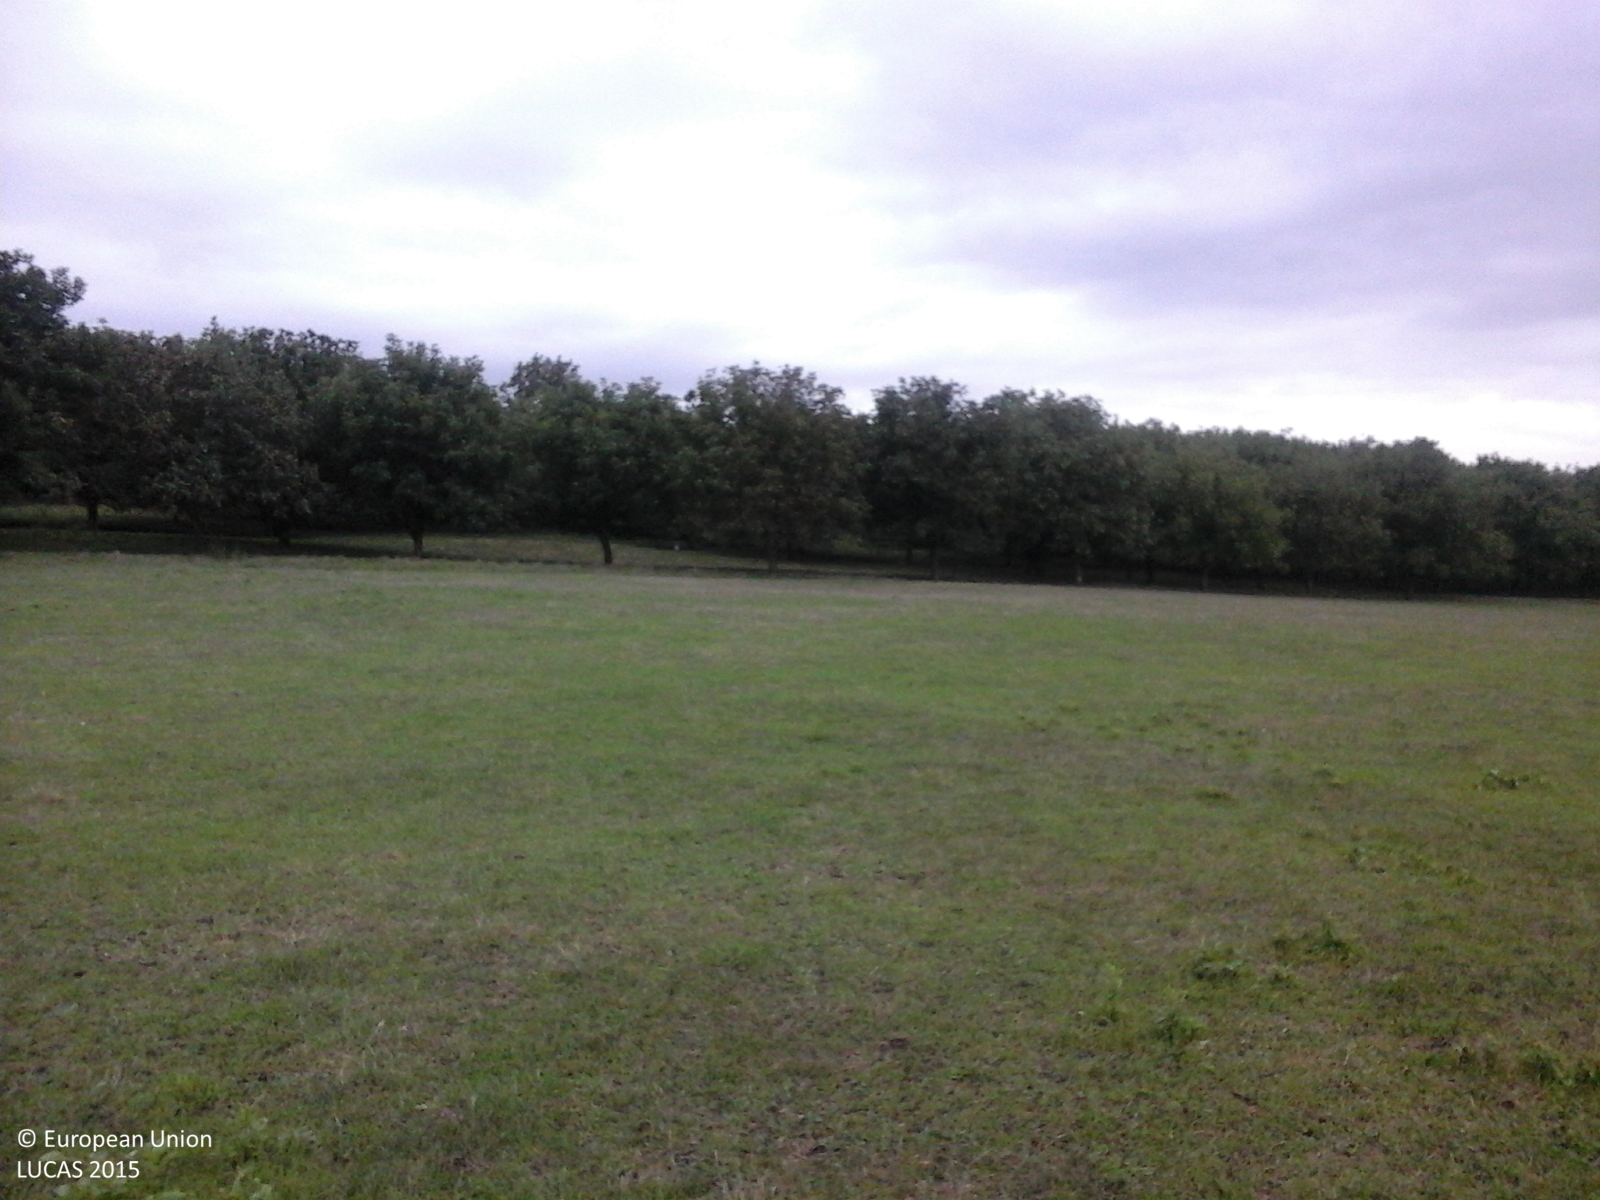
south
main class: Grassland
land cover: Grassland without tree/shrub cover
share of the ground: > 75 %
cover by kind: herbaceous plants 100 %
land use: Agriculture (excluding fallow land and kitchen gardens)
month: September
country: RO
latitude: 45.9832
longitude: 23.5022
